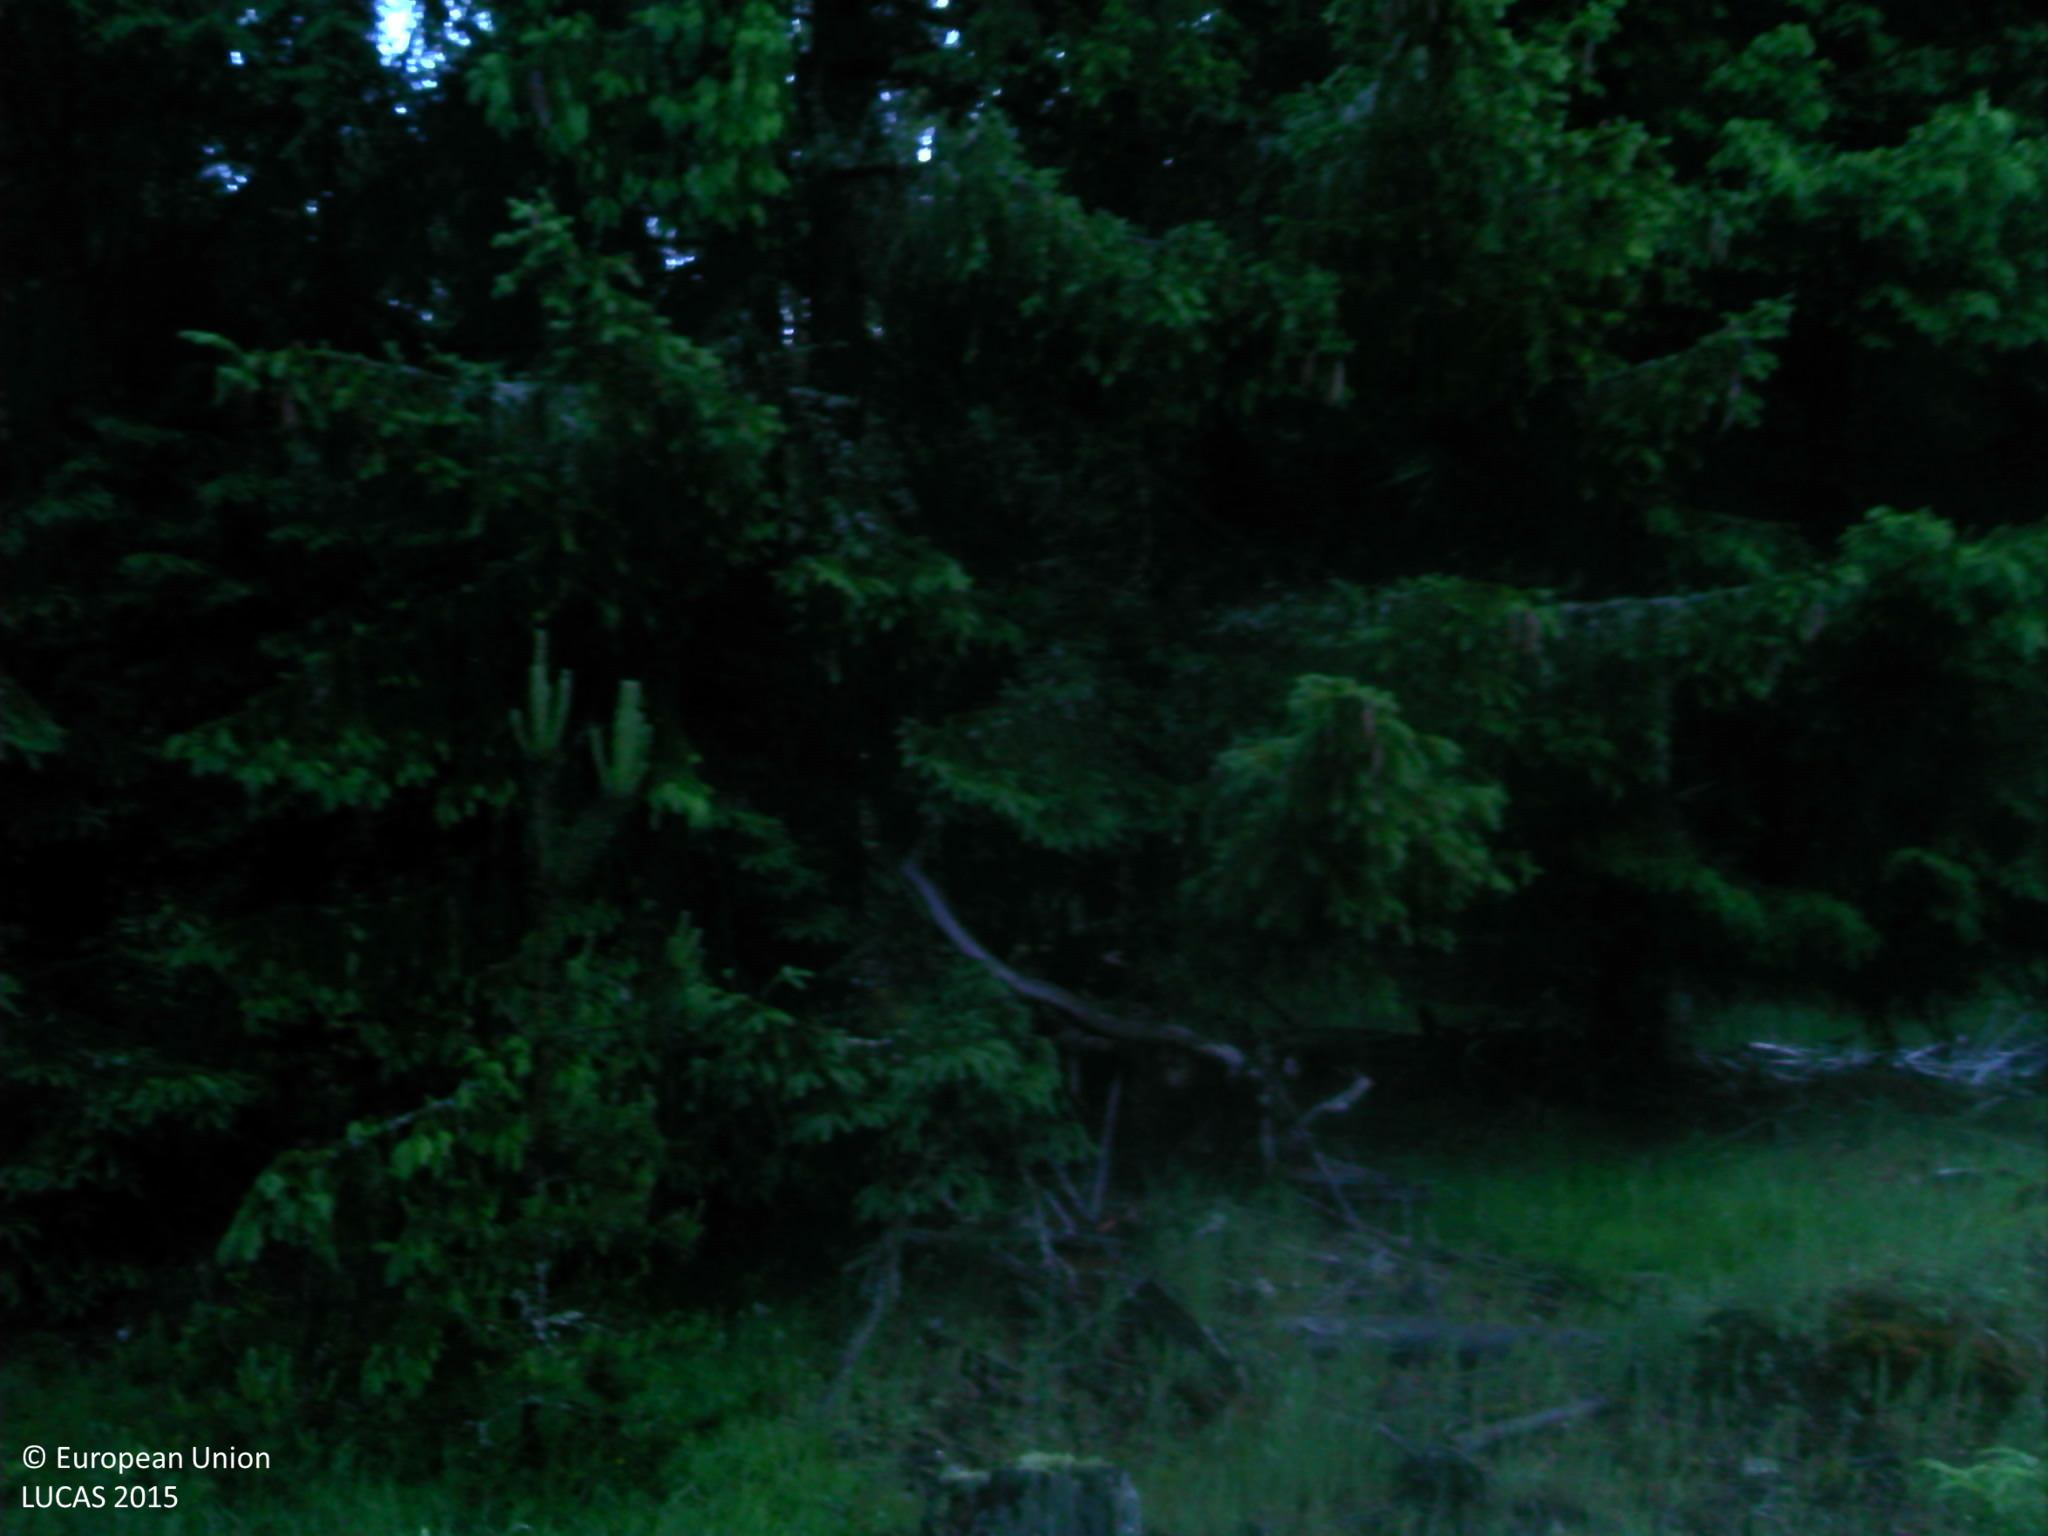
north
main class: Woodland
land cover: Spruce dominated coniferous woodland
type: alpine coniferous forest
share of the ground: > 75 %
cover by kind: coniferous forest trees 50 %, herbaceous plants 40 %, shrubs 5 %, lichens and mosses 5 %
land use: Forestry
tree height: > 5 m
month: June
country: FR
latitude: 45.1919
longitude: 2.8859
